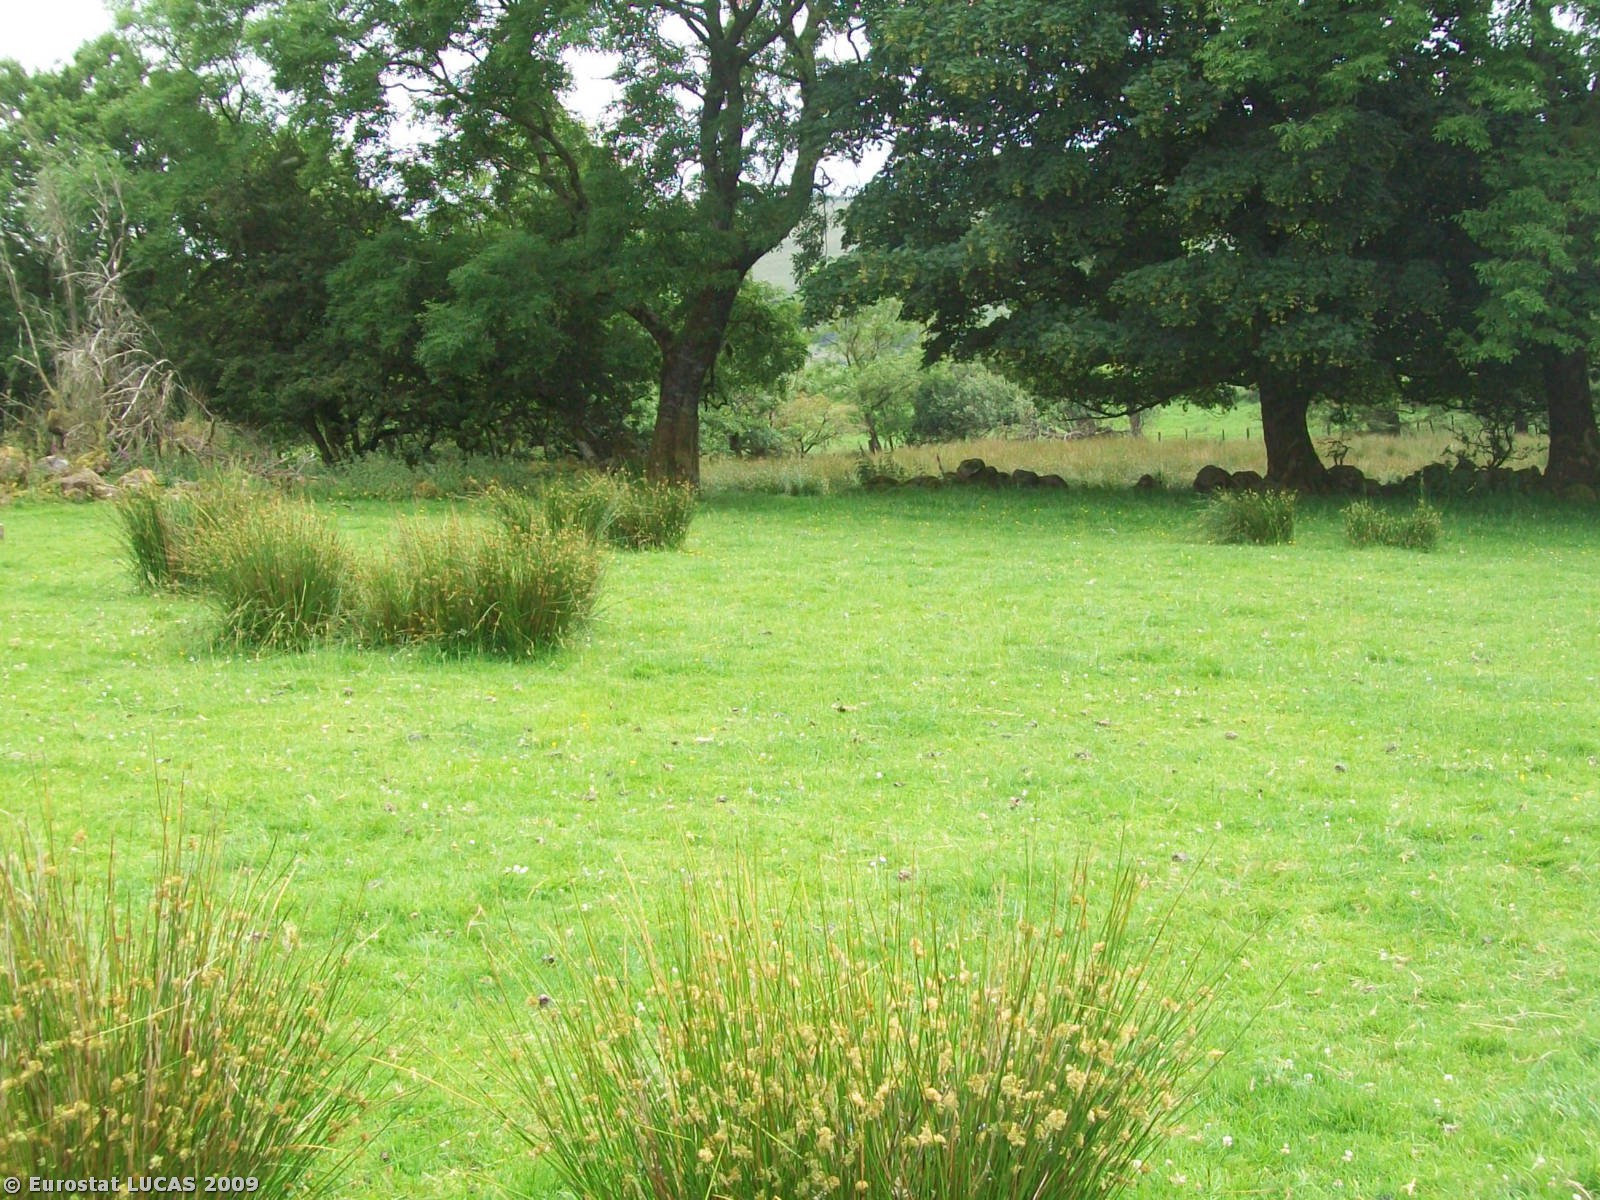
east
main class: Grassland
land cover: Grassland without tree/shrub cover
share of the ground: > 75 %
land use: Agriculture (excluding fallow land and kitchen gardens)
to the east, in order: Grassland without tree/shrub cover; Dry stone walls; Abandoned hedges; Grassland without tree/shrub cover; Abandoned hedges; Dry stone walls; Fences; Grassland without tree/shrub cover; Electric lines; Grassland without tree/shrub cover; Fences; Single bushes/trees; Grass margins; Tracks; Grass margins; Fences; Grassland without tree/shrub cover; Fences; Abandoned hedges; Fences; Grassland without tree/shrub cover
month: July
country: GB
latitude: 54.9407
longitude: -6.7873
